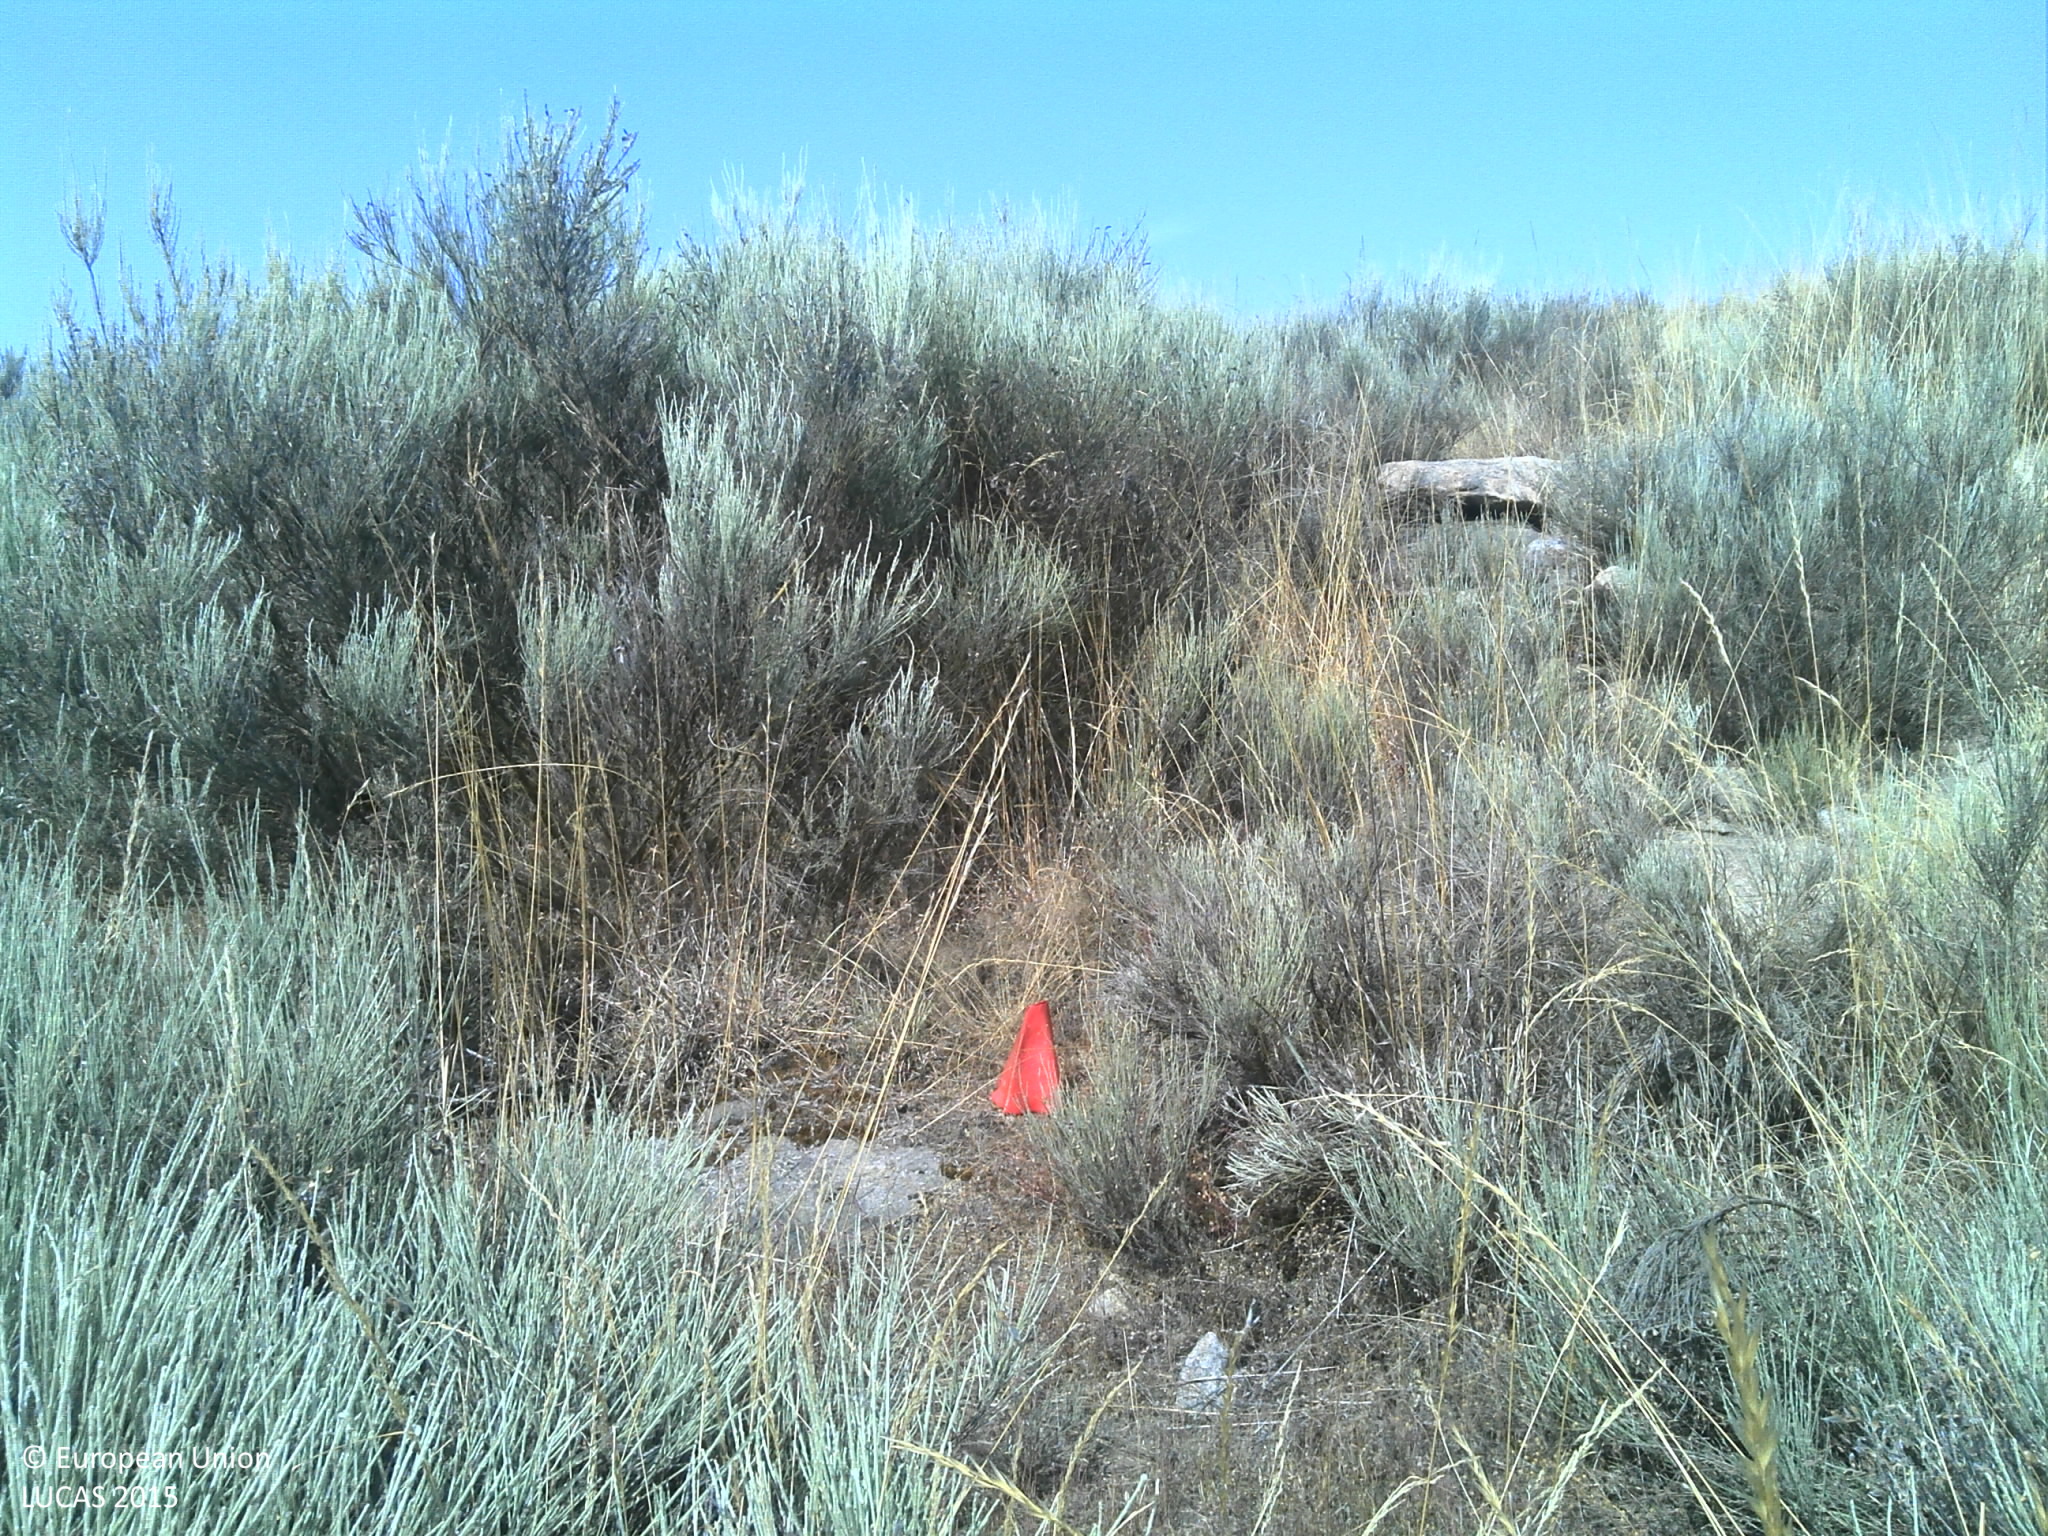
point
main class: Shrubland
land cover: Shrubland without tree cover
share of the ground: 50 - 75 %
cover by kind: shrubs 55 %, herbaceous plants 15 %, consolidated bare surface 15 %, unconsolidated bare surface 15 %
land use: Semi-natural and natural areas not in use
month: July
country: PT
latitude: 40.9539
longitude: -7.3774
